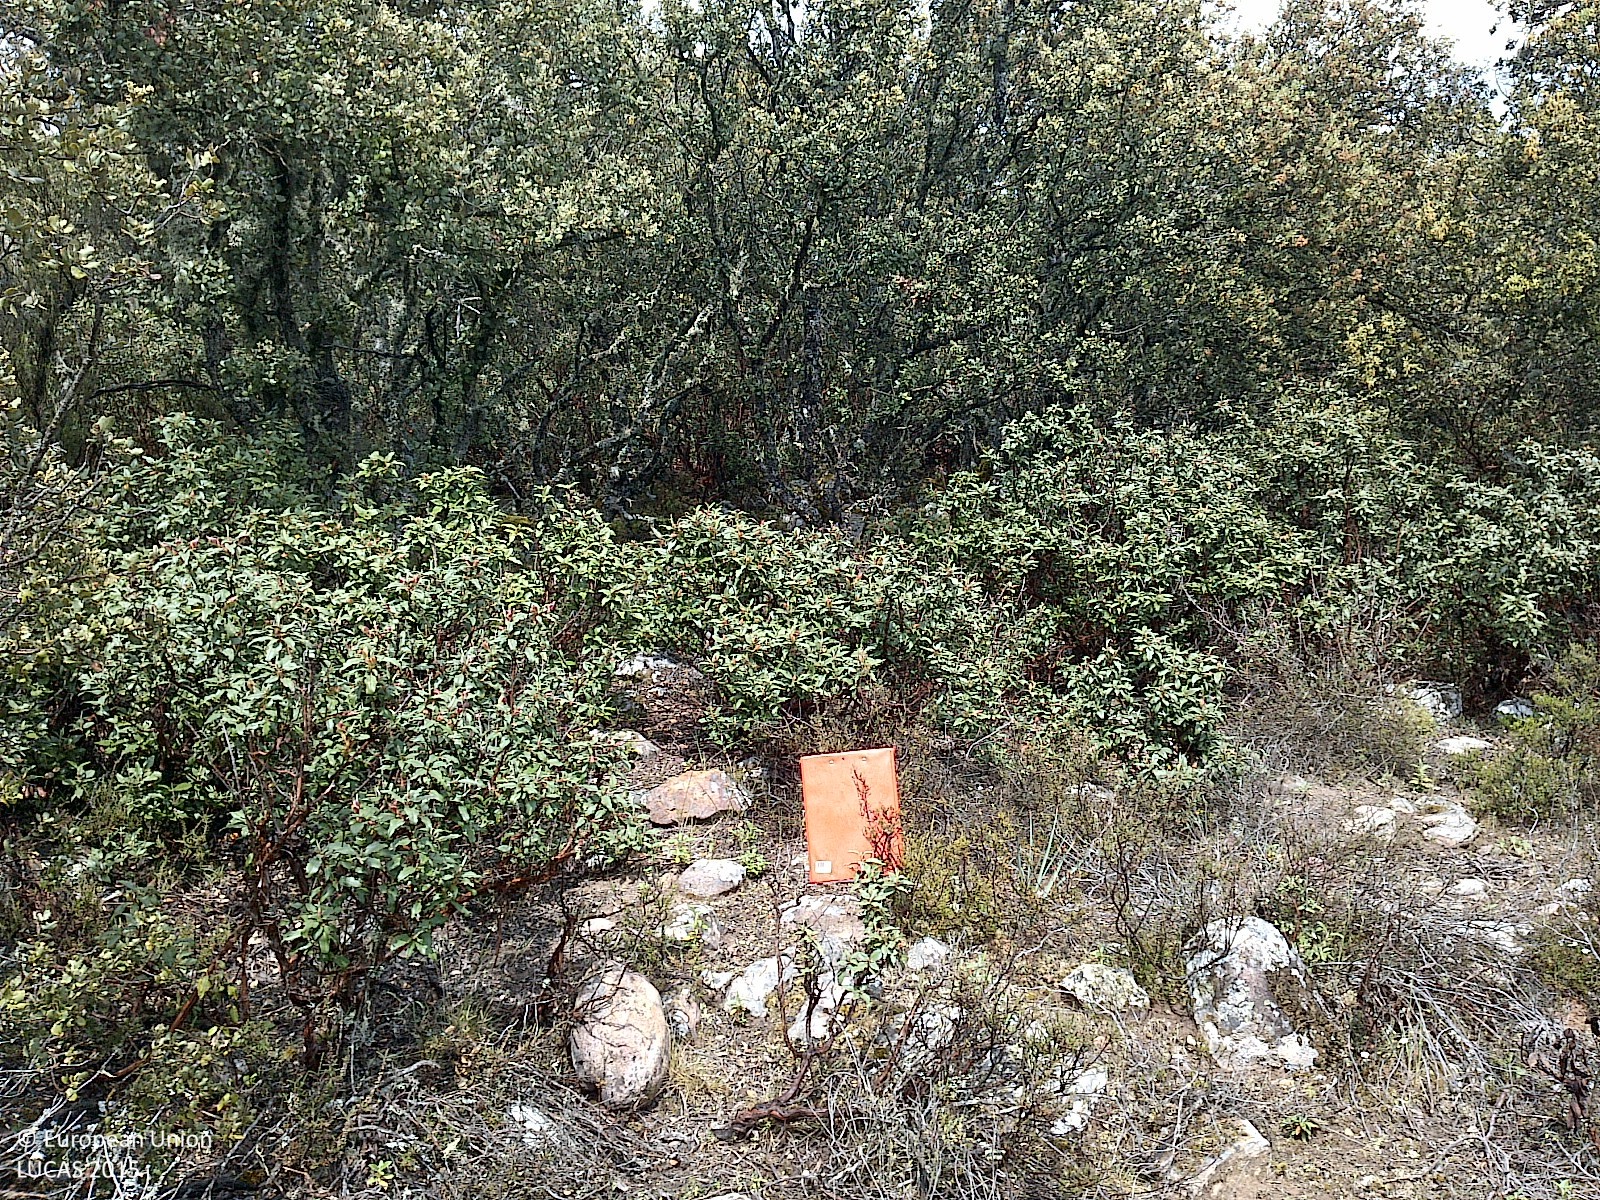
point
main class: Woodland
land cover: Broadleaved woodland
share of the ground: > 75 %
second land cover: Shrubland without tree cover
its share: 50 - 75 %
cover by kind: broadleaved forest trees 75 %, shrubs 15 %, herbaceous plants 5 %, consolidated bare surface 5 %
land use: Forestry
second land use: Agriculture (excluding fallow land and kitchen gardens)
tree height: < 5 m
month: May
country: ES
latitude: 41.8156
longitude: -2.2548
